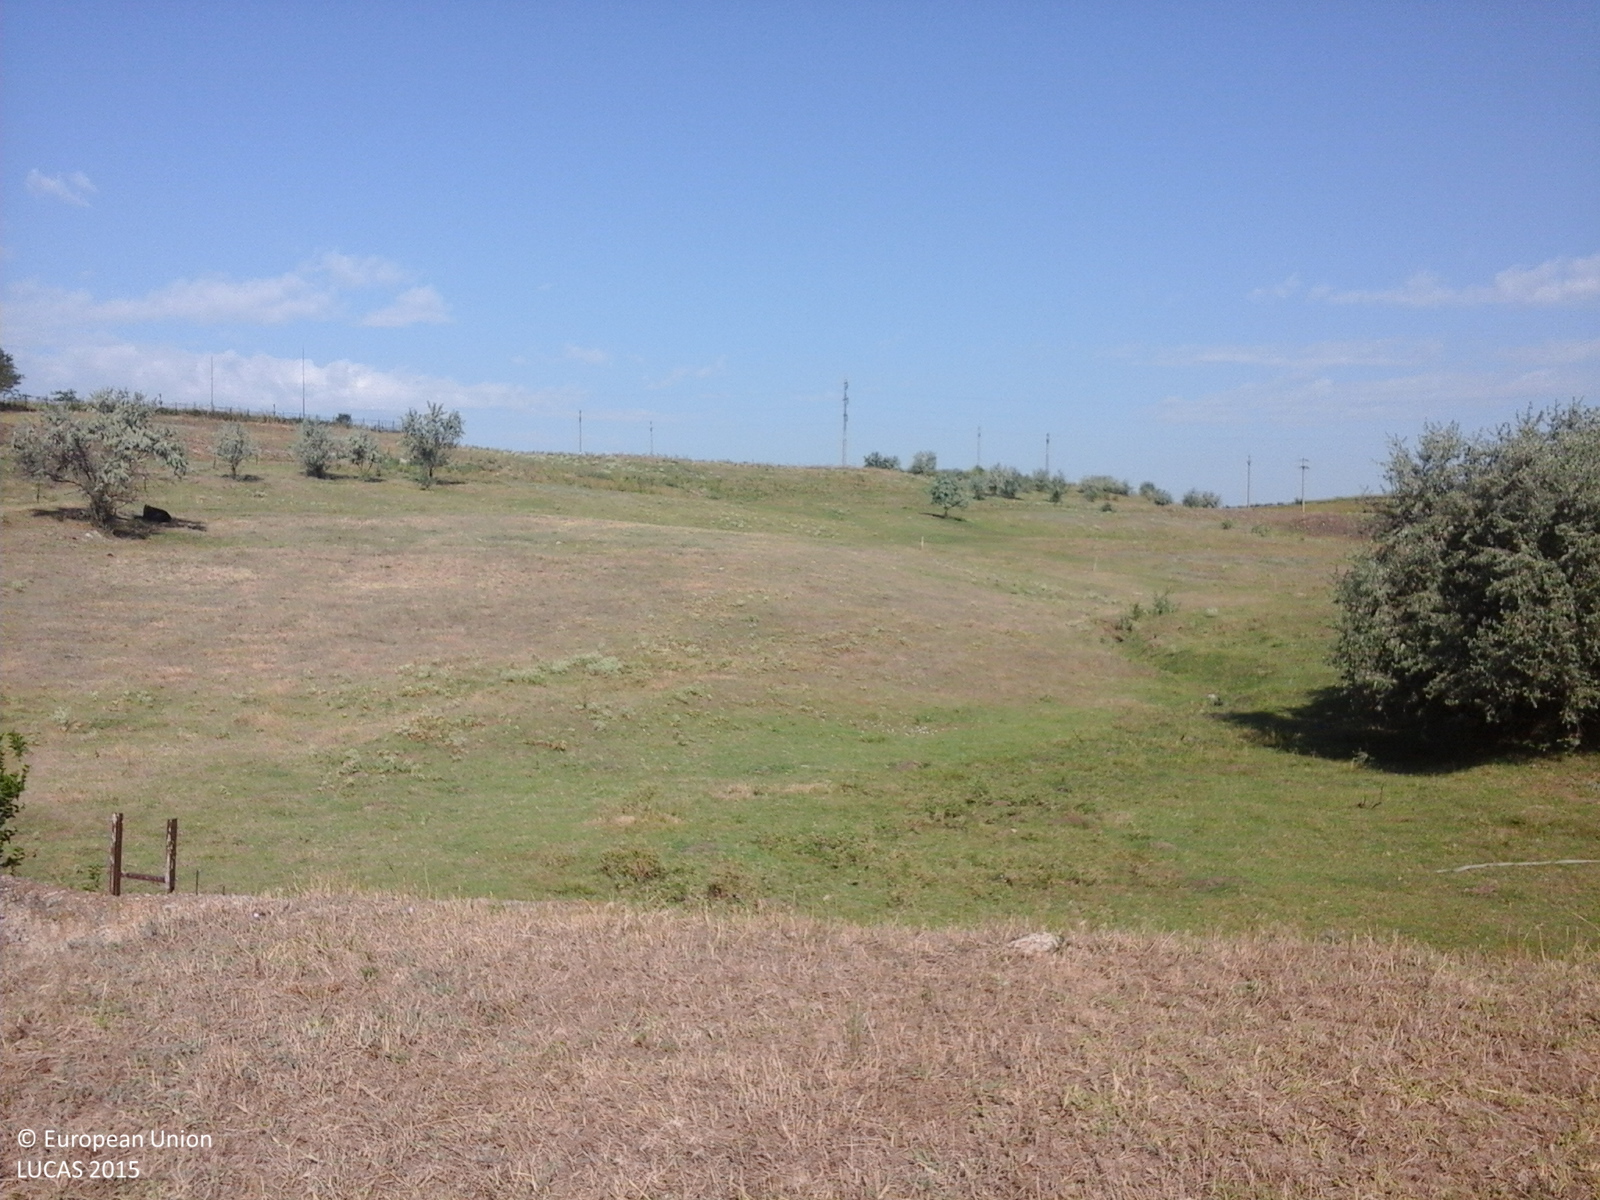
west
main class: Grassland
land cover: Grassland with sparse tree/shrub cover
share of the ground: > 75 %
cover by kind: herbaceous plants 85 %, shrubs 10 %, broadleaved forest trees 5 %
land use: Agriculture (excluding fallow land and kitchen gardens)
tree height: < 5 m
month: July
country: RO
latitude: 46.3138
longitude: 28.1411
